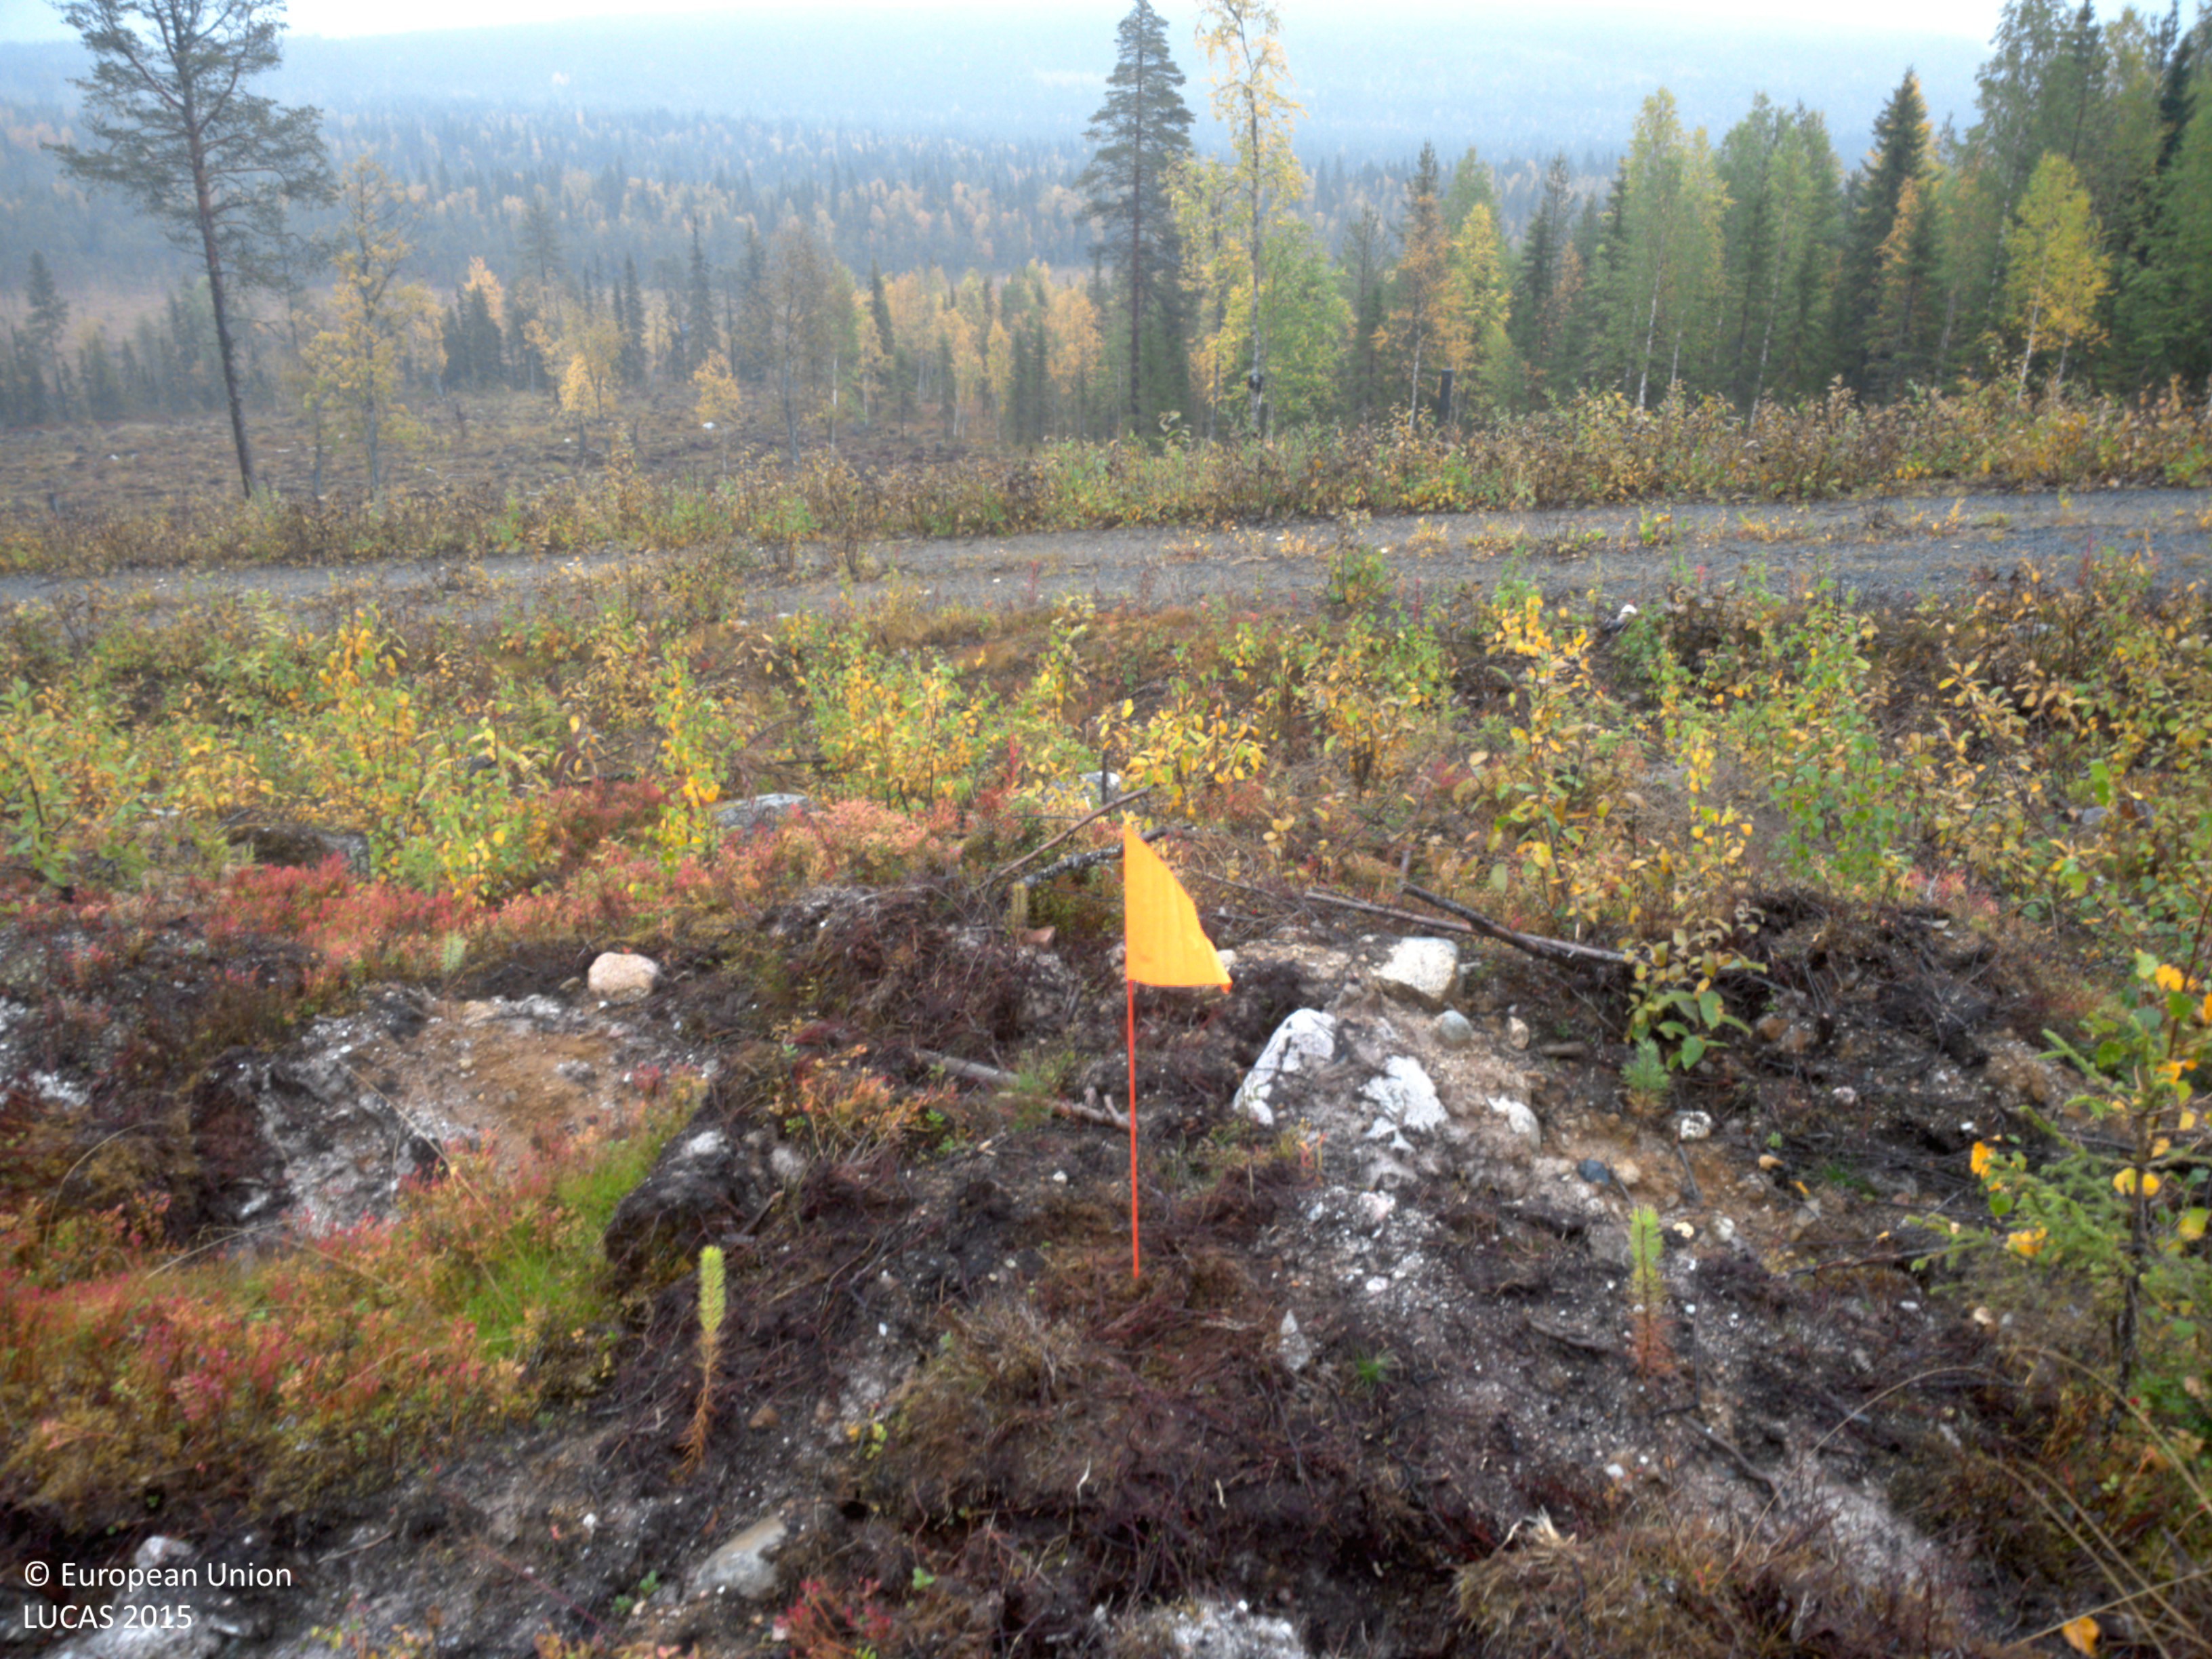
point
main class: Shrubland
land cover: Shrubland with sparse tree cover
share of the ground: 50 - 75 %
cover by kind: shrubs 65 %, unconsolidated bare surface 25 %, coniferous forest trees 5 %, consolidated bare surface 5 %
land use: Forestry
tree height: < 5 m
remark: Clear cut
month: September
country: SE
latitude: 64.8932
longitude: 19.2398
